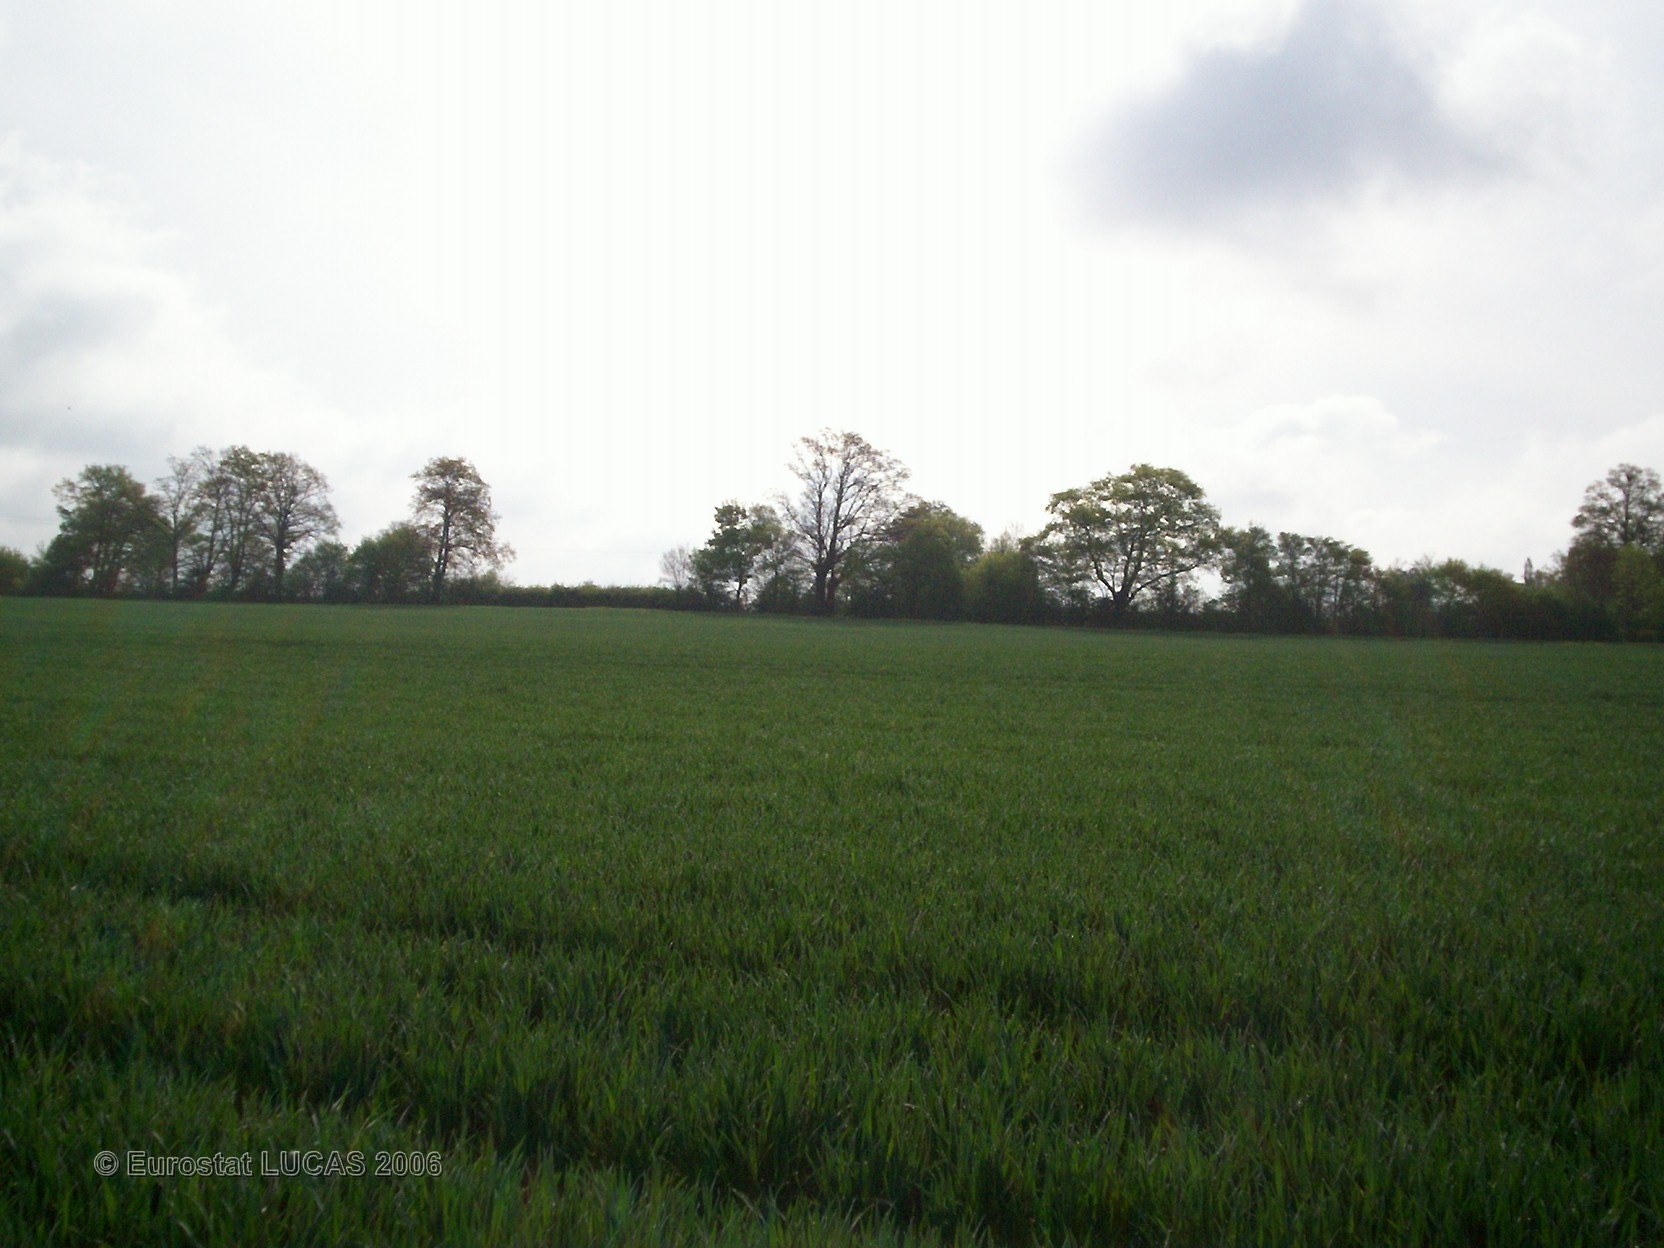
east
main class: Cropland
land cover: Common wheat
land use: Agriculture (excluding fallow land and kitchen gardens)
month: May
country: FR
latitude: 48.6260
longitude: 0.2721
